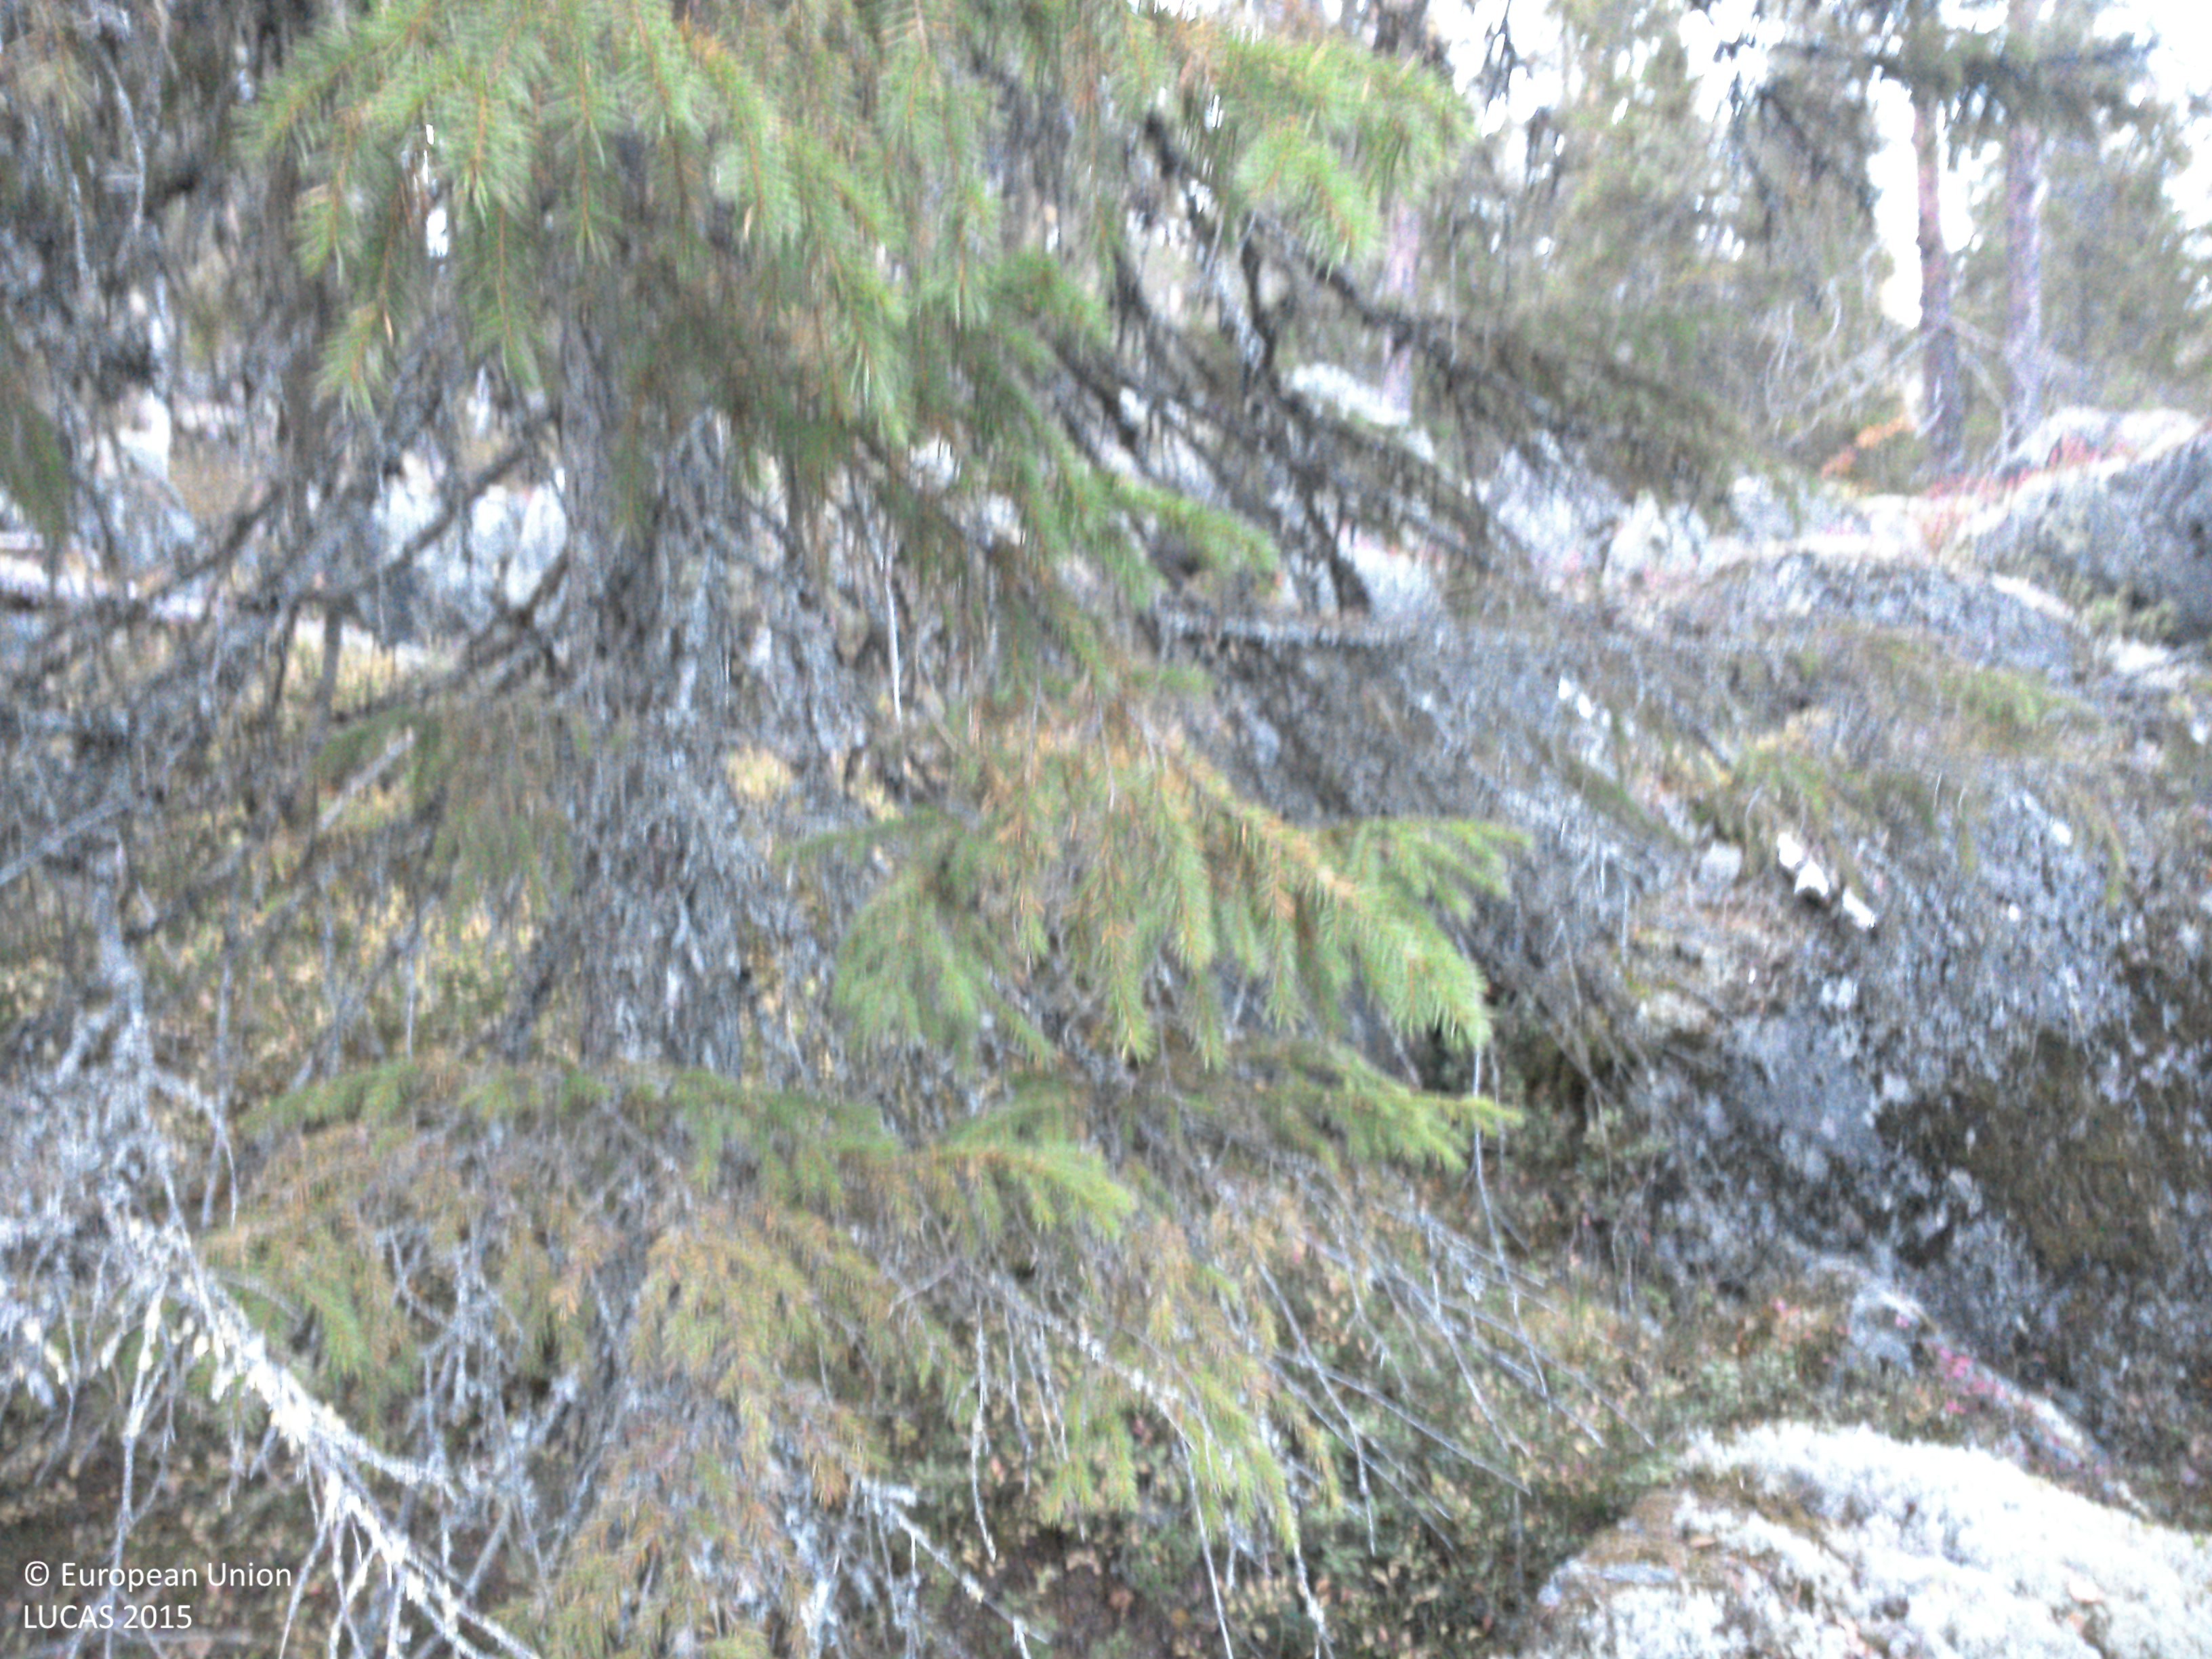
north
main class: Woodland
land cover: Other coniferous woodland
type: boreal forest
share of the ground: 50 - 75 %
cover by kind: coniferous forest trees 50 %, shrubs 50 %
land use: Forestry
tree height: > 5 m
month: October
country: SE
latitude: 63.8192
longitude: 19.8319
